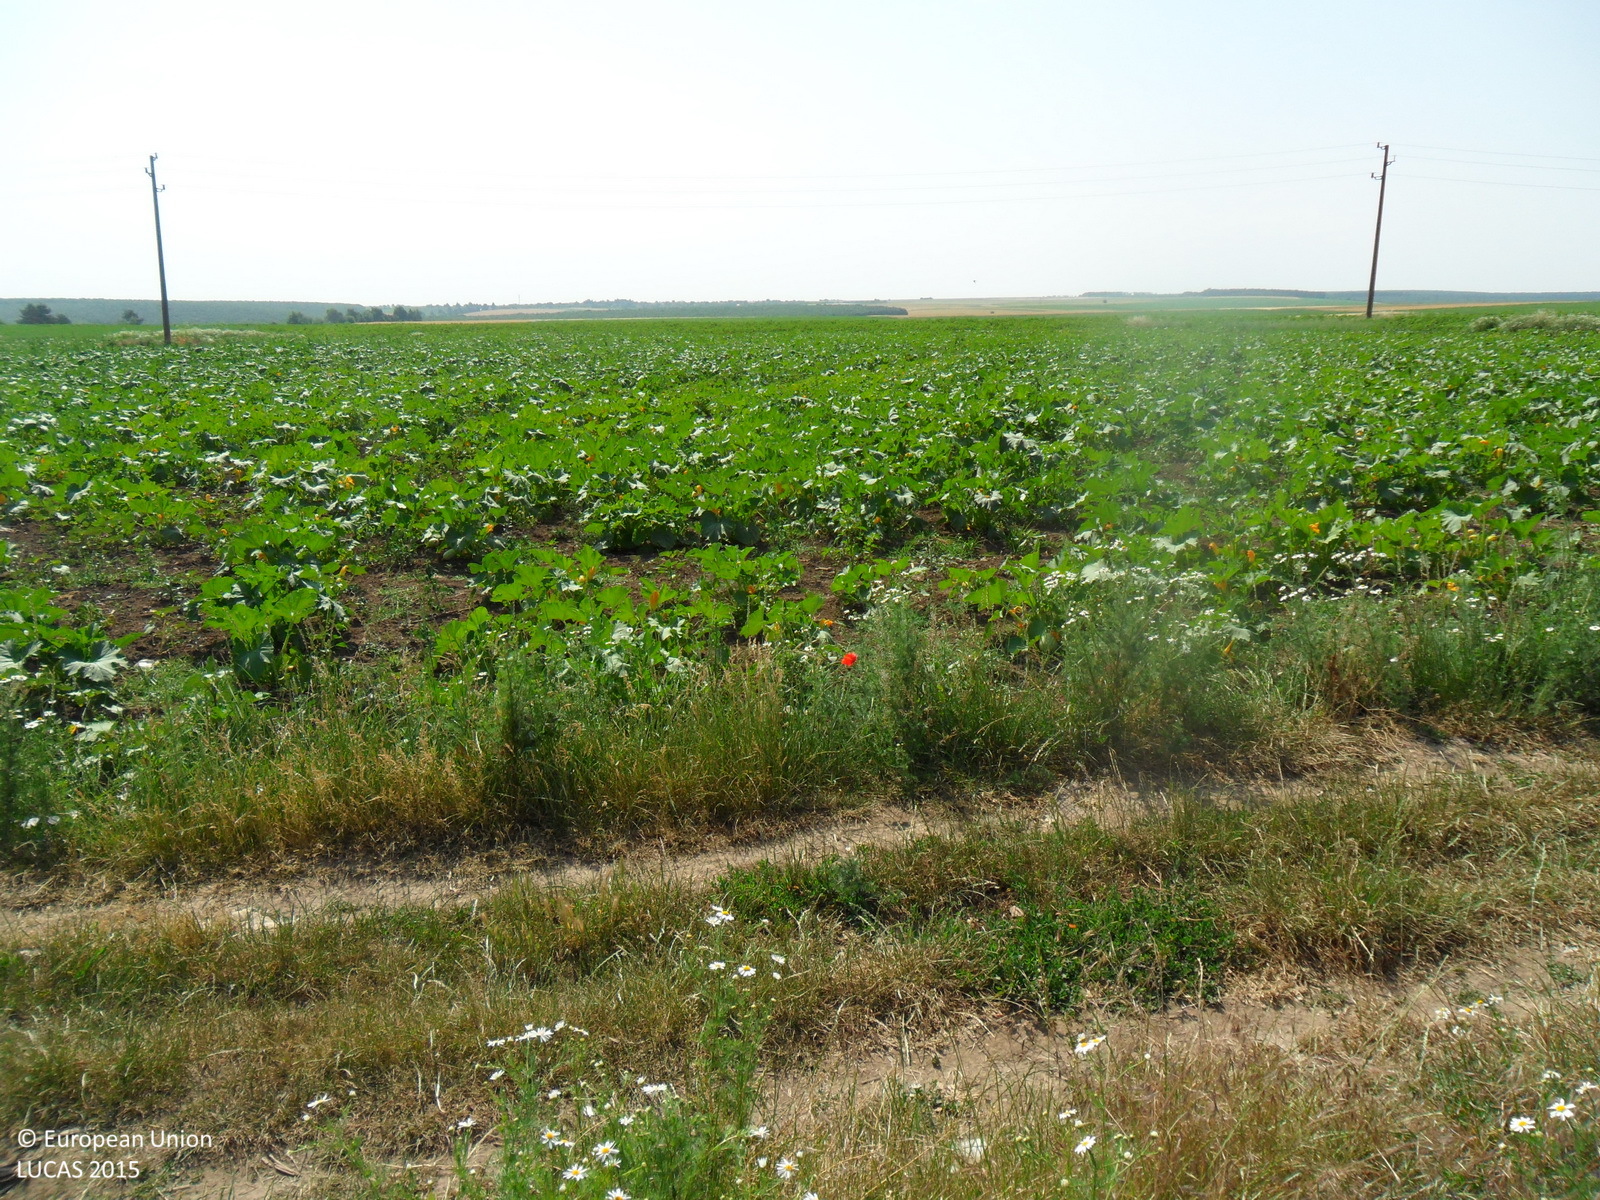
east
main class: Cropland
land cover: Other fresh vegetables
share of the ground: 50 - 75 %
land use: Agriculture (excluding fallow land and kitchen gardens)
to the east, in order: Other fresh vegetables; Grass margins; Tracks; Grass margins; Other fresh vegetables; Shruby margins; Lucerne; Electric lines; Lucerne; Shruby margins; Lucerne
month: June
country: BG
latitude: 43.6661
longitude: 26.9214
